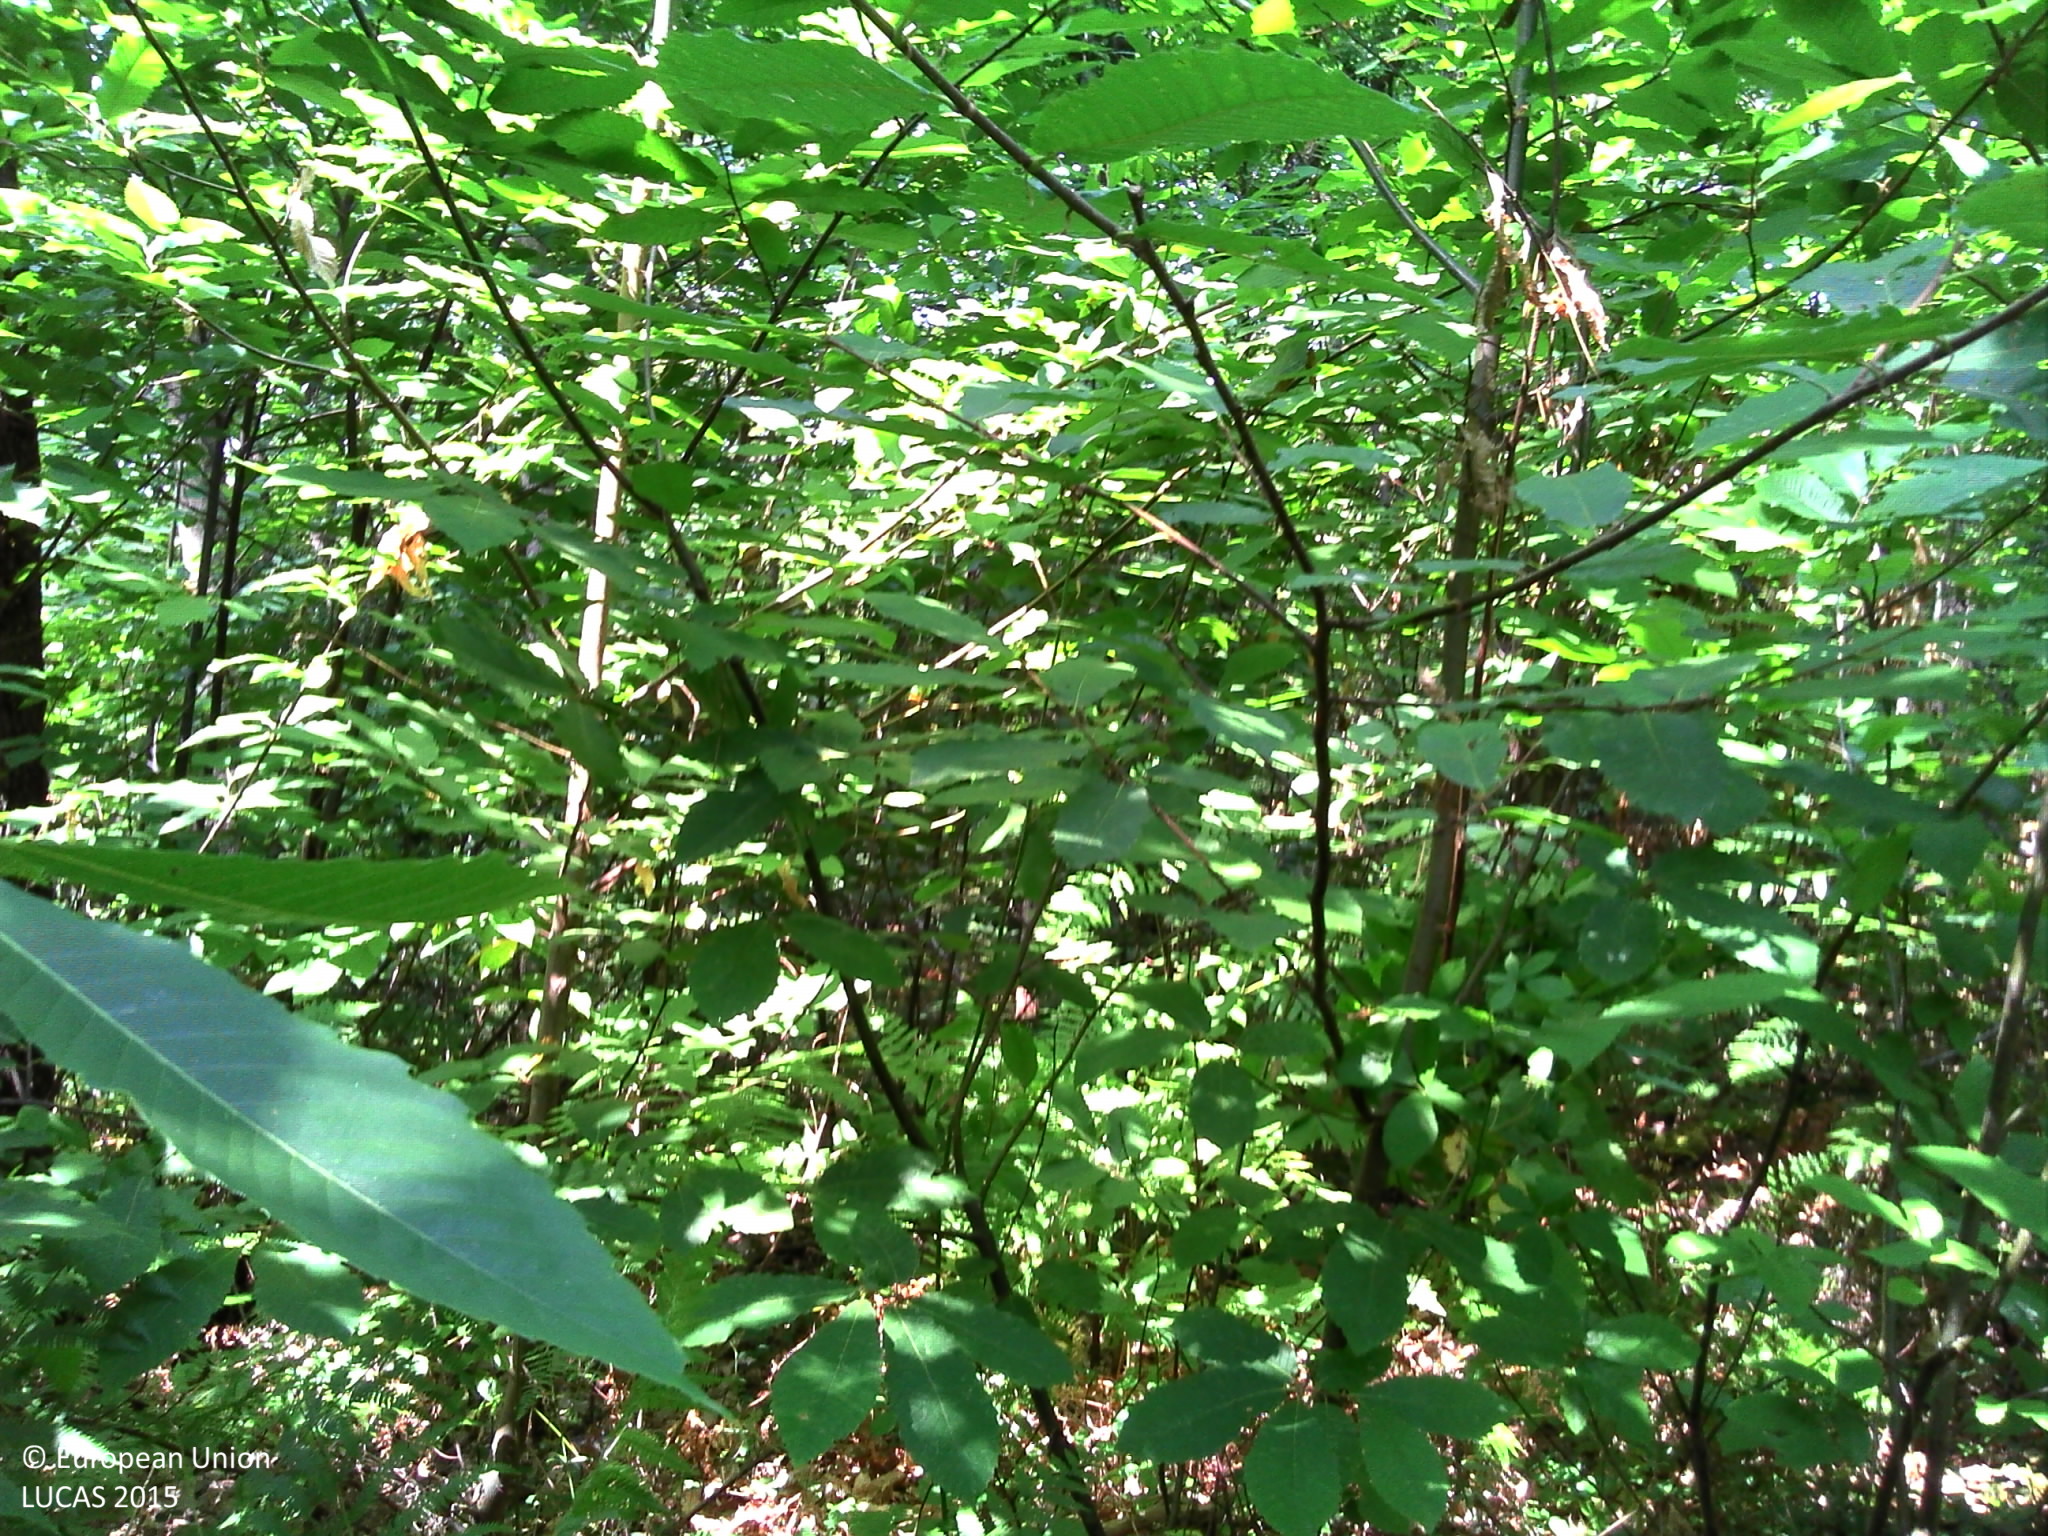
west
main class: Woodland
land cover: Broadleaved woodland
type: thermophilous deciduous forest
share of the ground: > 75 %
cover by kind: broadleaved forest trees 70 %, shrubs 15 %, herbaceous plants 15 %
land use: Forestry
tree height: > 5 m
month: July
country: FR
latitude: 45.1469
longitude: 0.6930
